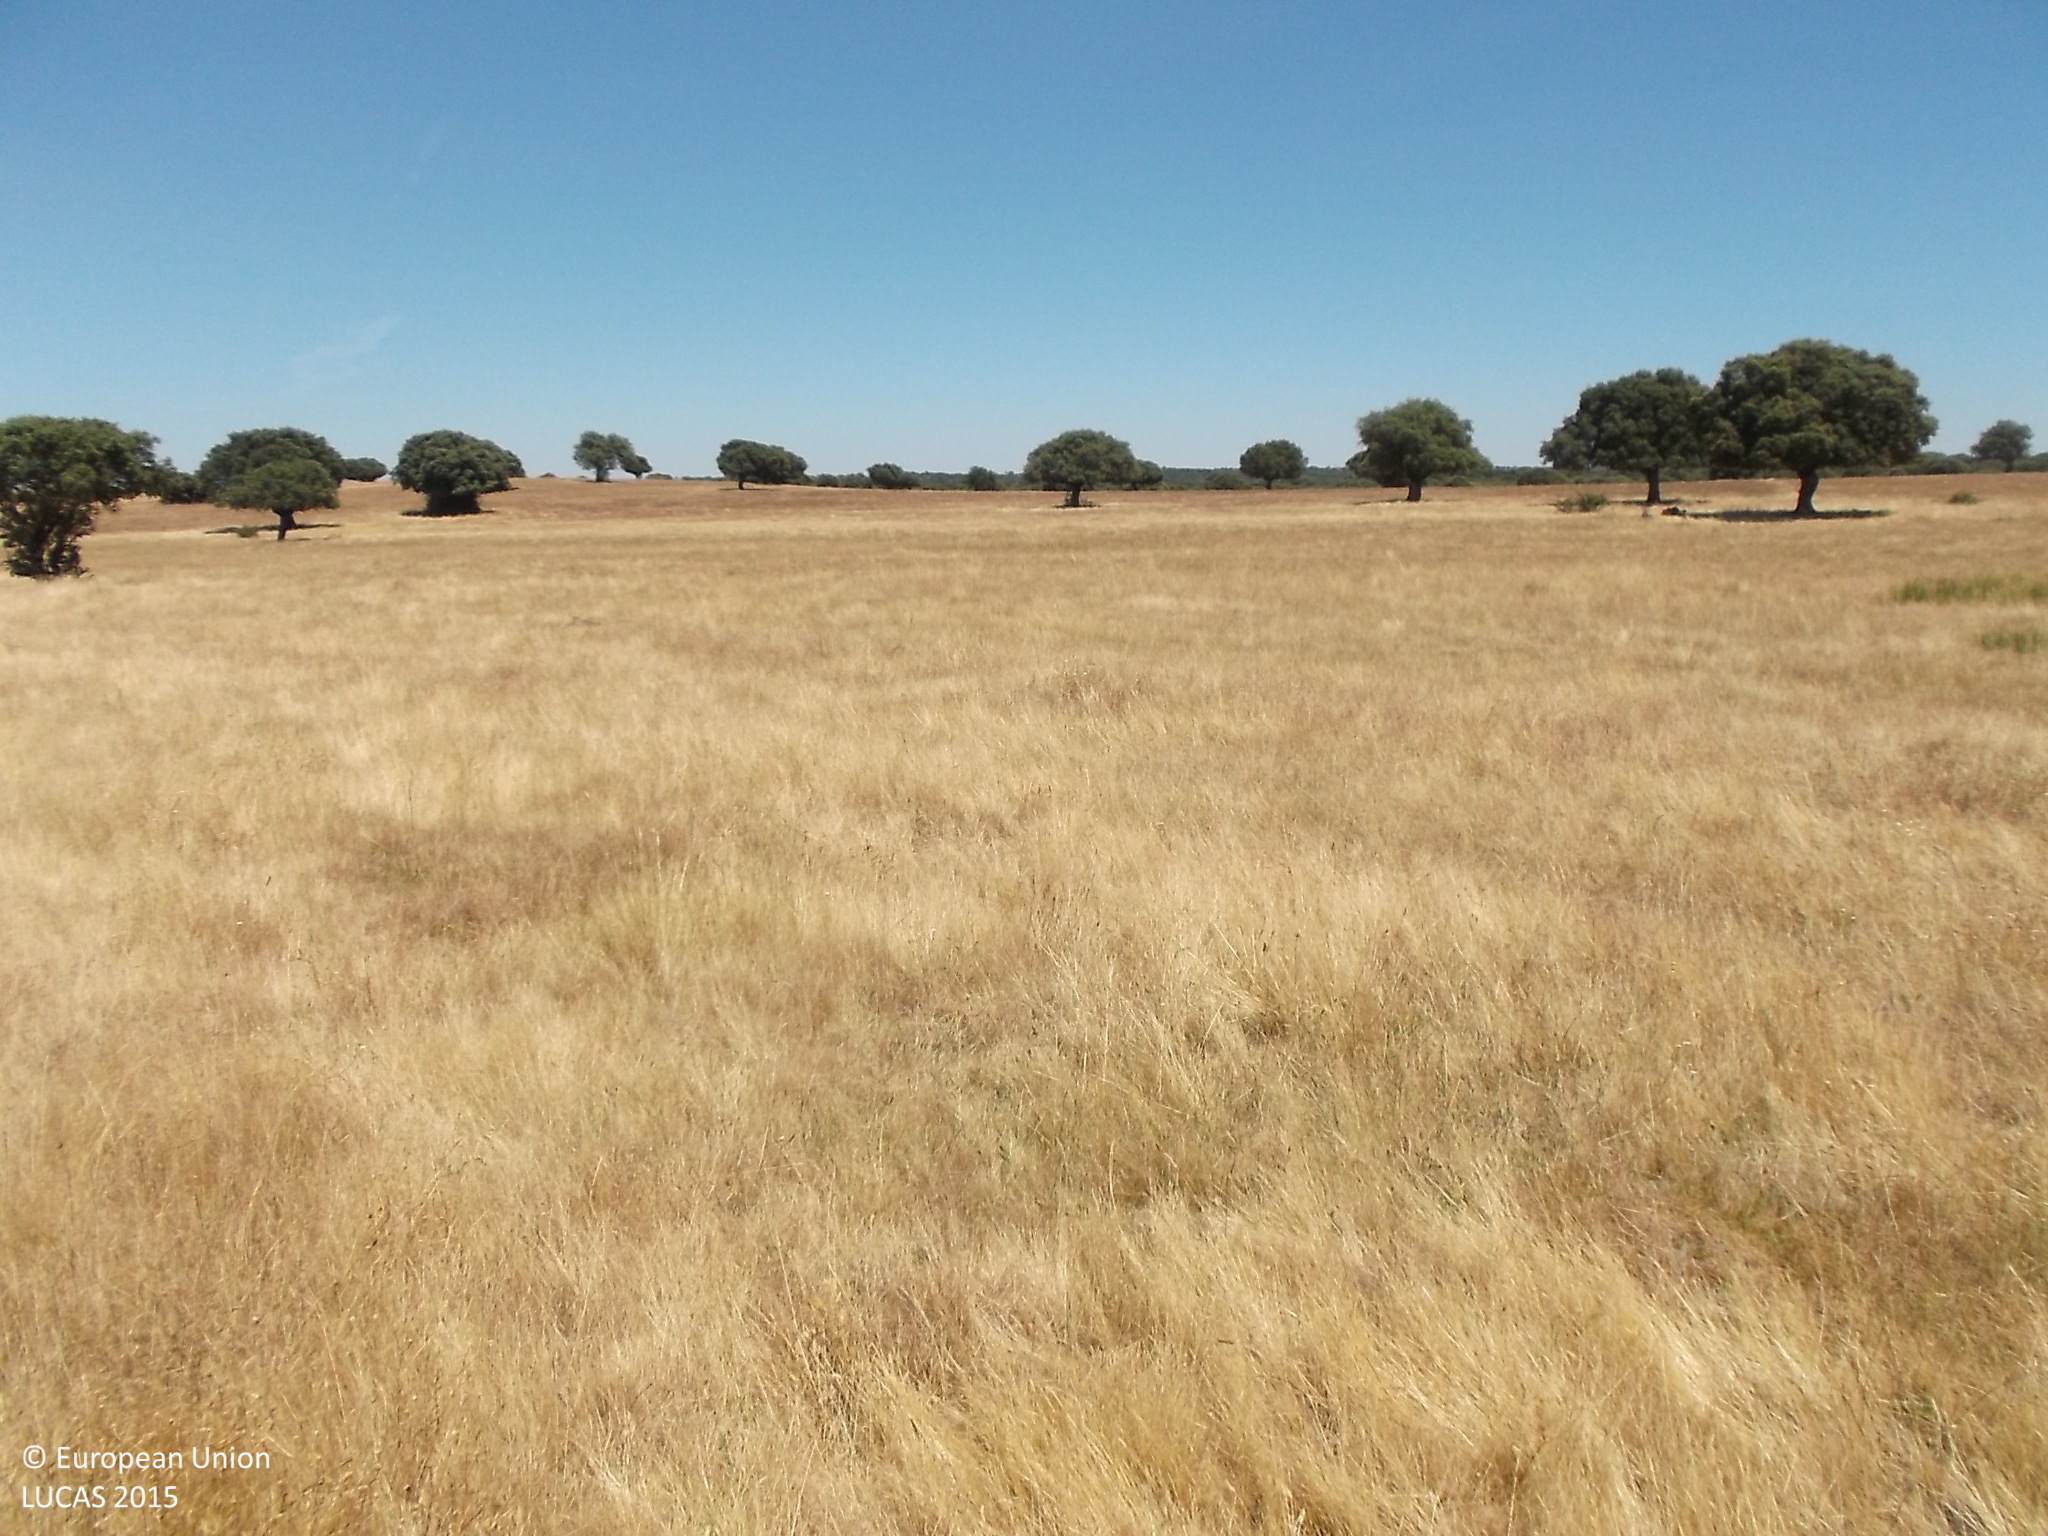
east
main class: Grassland
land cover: Grassland with sparse tree/shrub cover
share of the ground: > 75 %
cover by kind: herbaceous plants 90 %, broadleaved forest trees 5 %, shrubs 5 %
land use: Agriculture (excluding fallow land and kitchen gardens)
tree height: < 5 m
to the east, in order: Grassland with sparse tree/shrub cover; Grassland without tree/shrub cover; Grassland with sparse tree/shrub cover
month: July
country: ES
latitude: 40.9635
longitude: -6.7956
